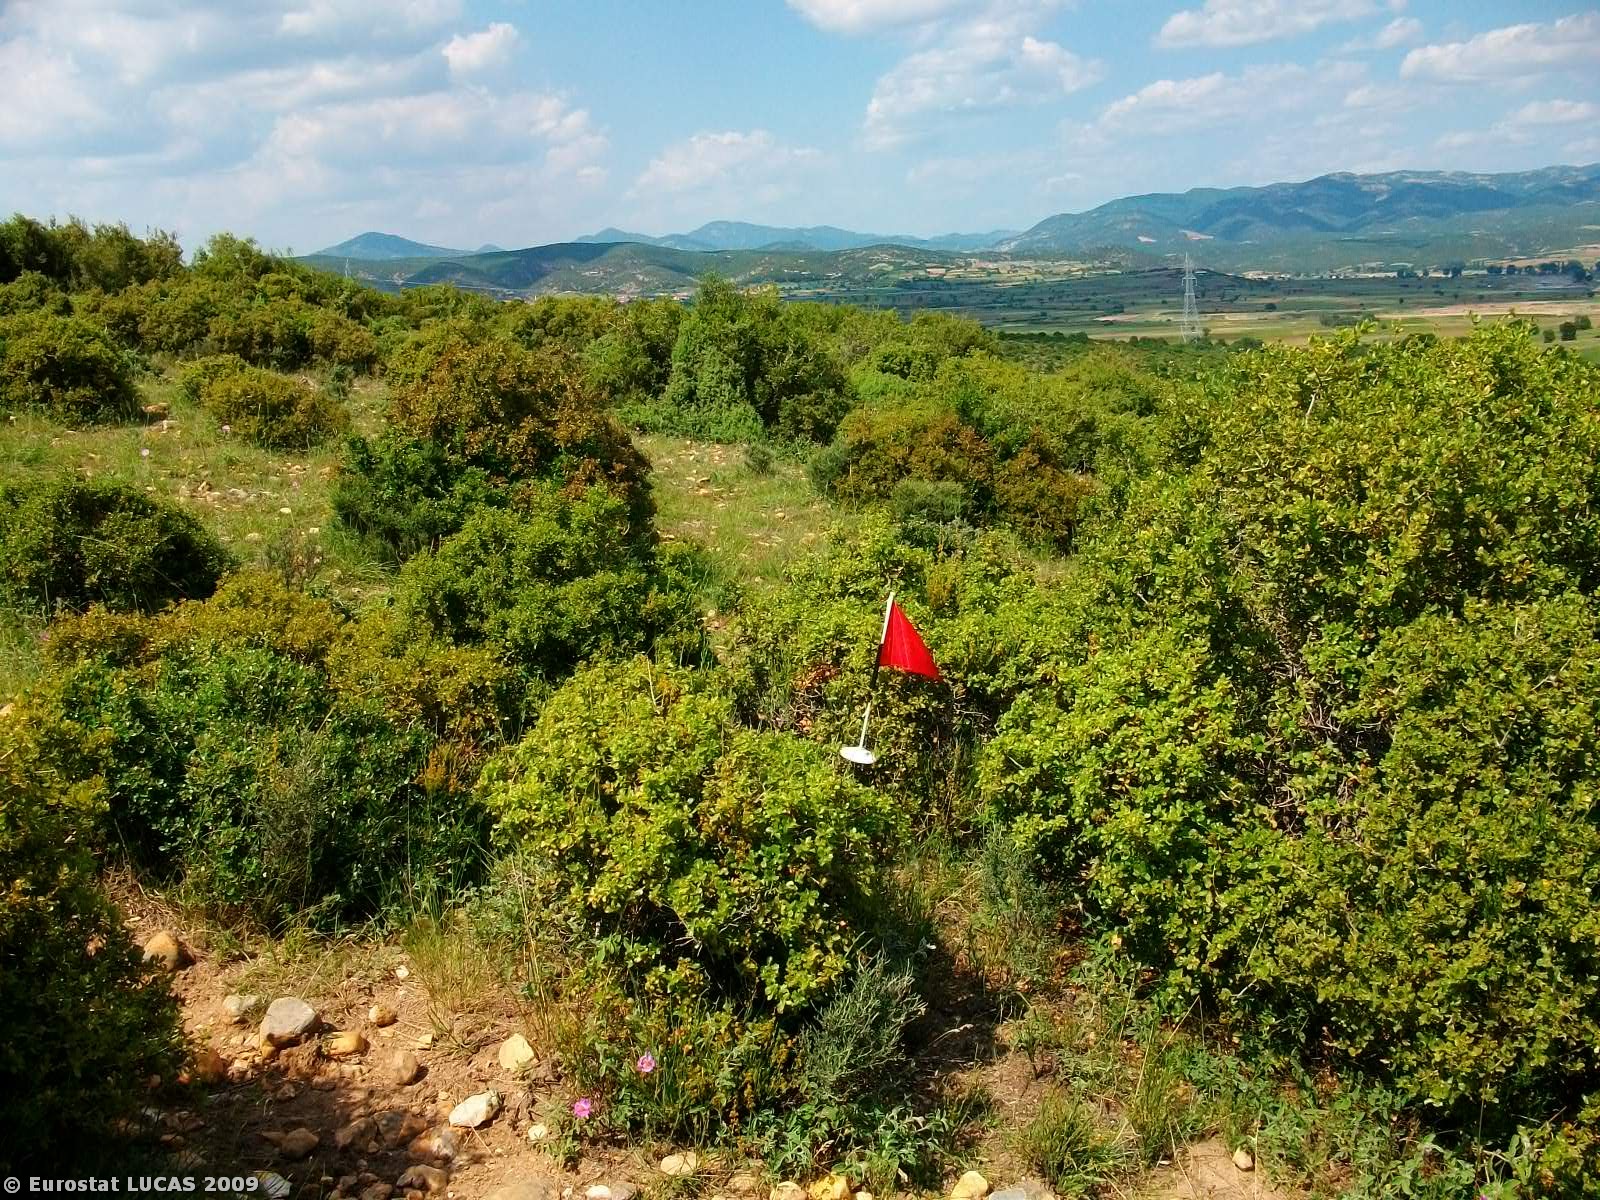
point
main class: Shrubland
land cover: Shrubland without tree cover
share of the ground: > 75 %
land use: Unused
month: May
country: GR
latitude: 41.1145
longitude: 25.5470
